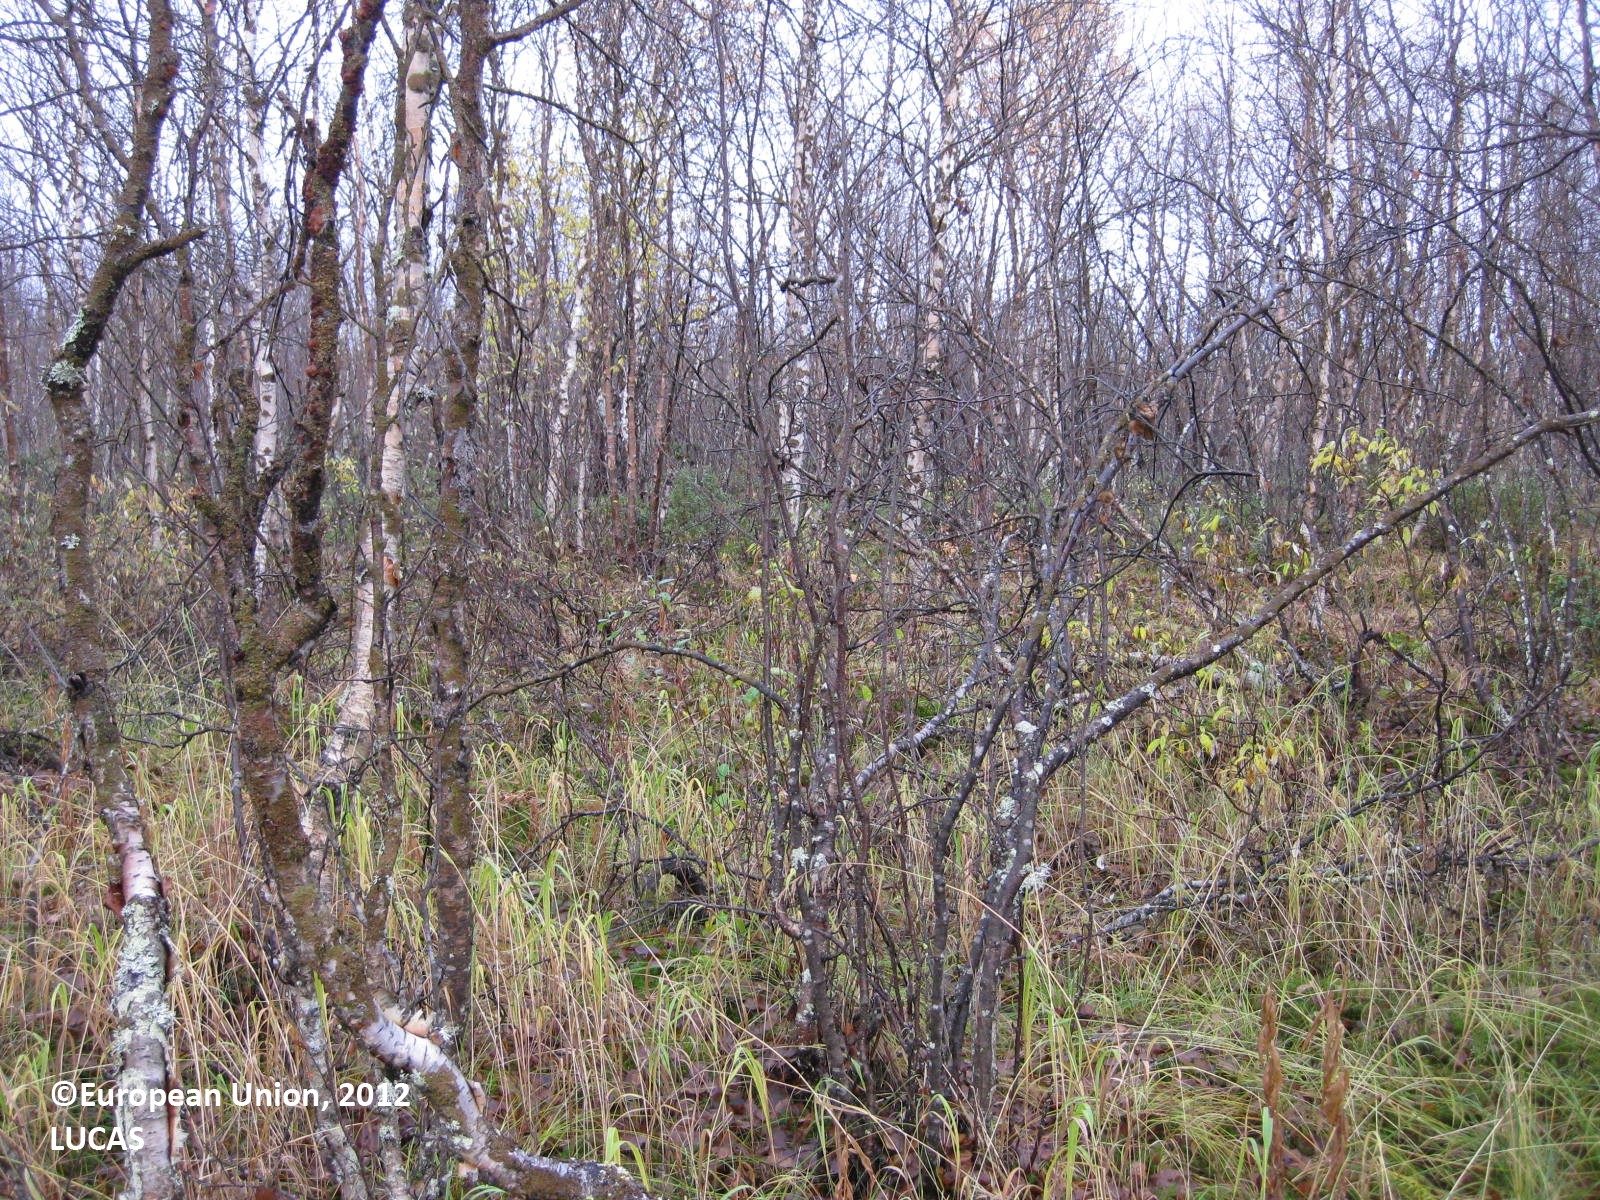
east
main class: Woodland
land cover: Broadleaved woodland
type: boreal forest
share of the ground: 50 - 75 %
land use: Forestry
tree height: > 5 m
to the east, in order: Broadleaved woodland; Paved roads, cycling and walking lanes; Broadleaved woodland; Ditches and canals; Tracks; Broadleaved woodland
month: September
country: FI
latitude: 68.4080
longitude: 23.9620
